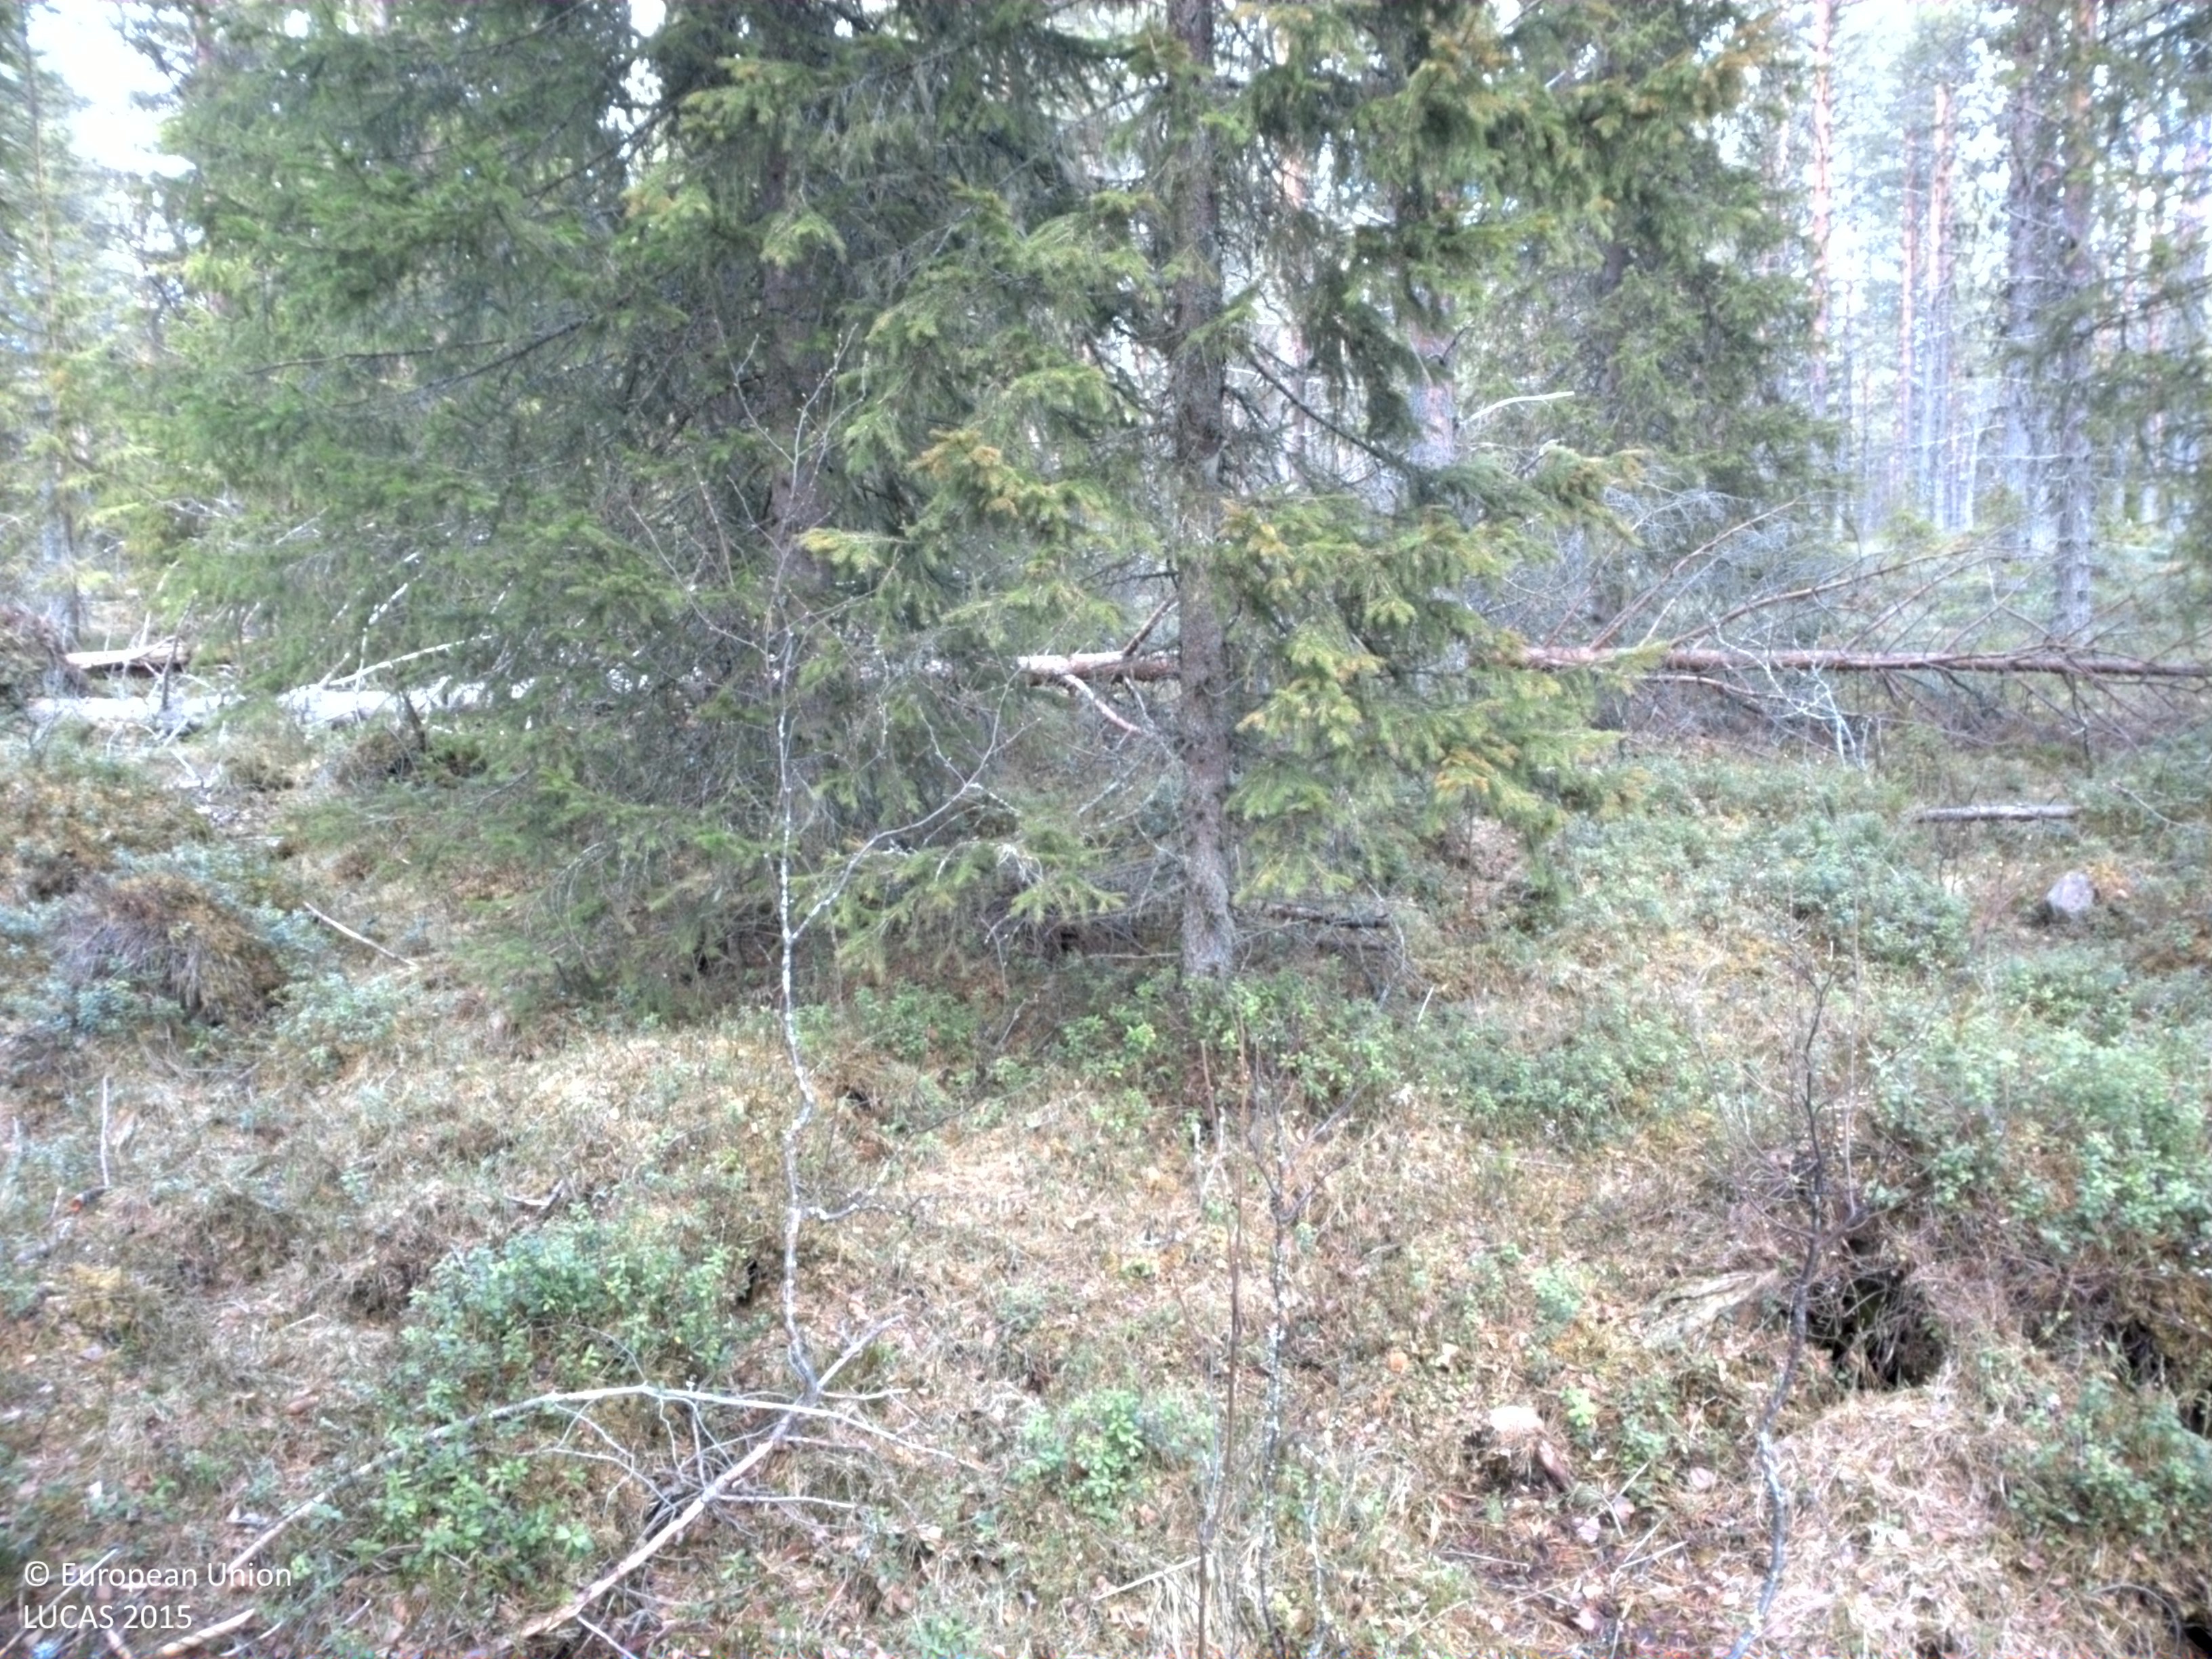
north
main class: Woodland
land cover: Pine dominated coniferous woodland
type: boreal forest
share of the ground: 50 - 75 %
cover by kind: coniferous forest trees 60 %, herbaceous plants 30 %, broadleaved forest trees 5 %, lichens and mosses 5 %
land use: Forestry
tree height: > 5 m
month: May
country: SE
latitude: 64.2631
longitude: 17.7503
